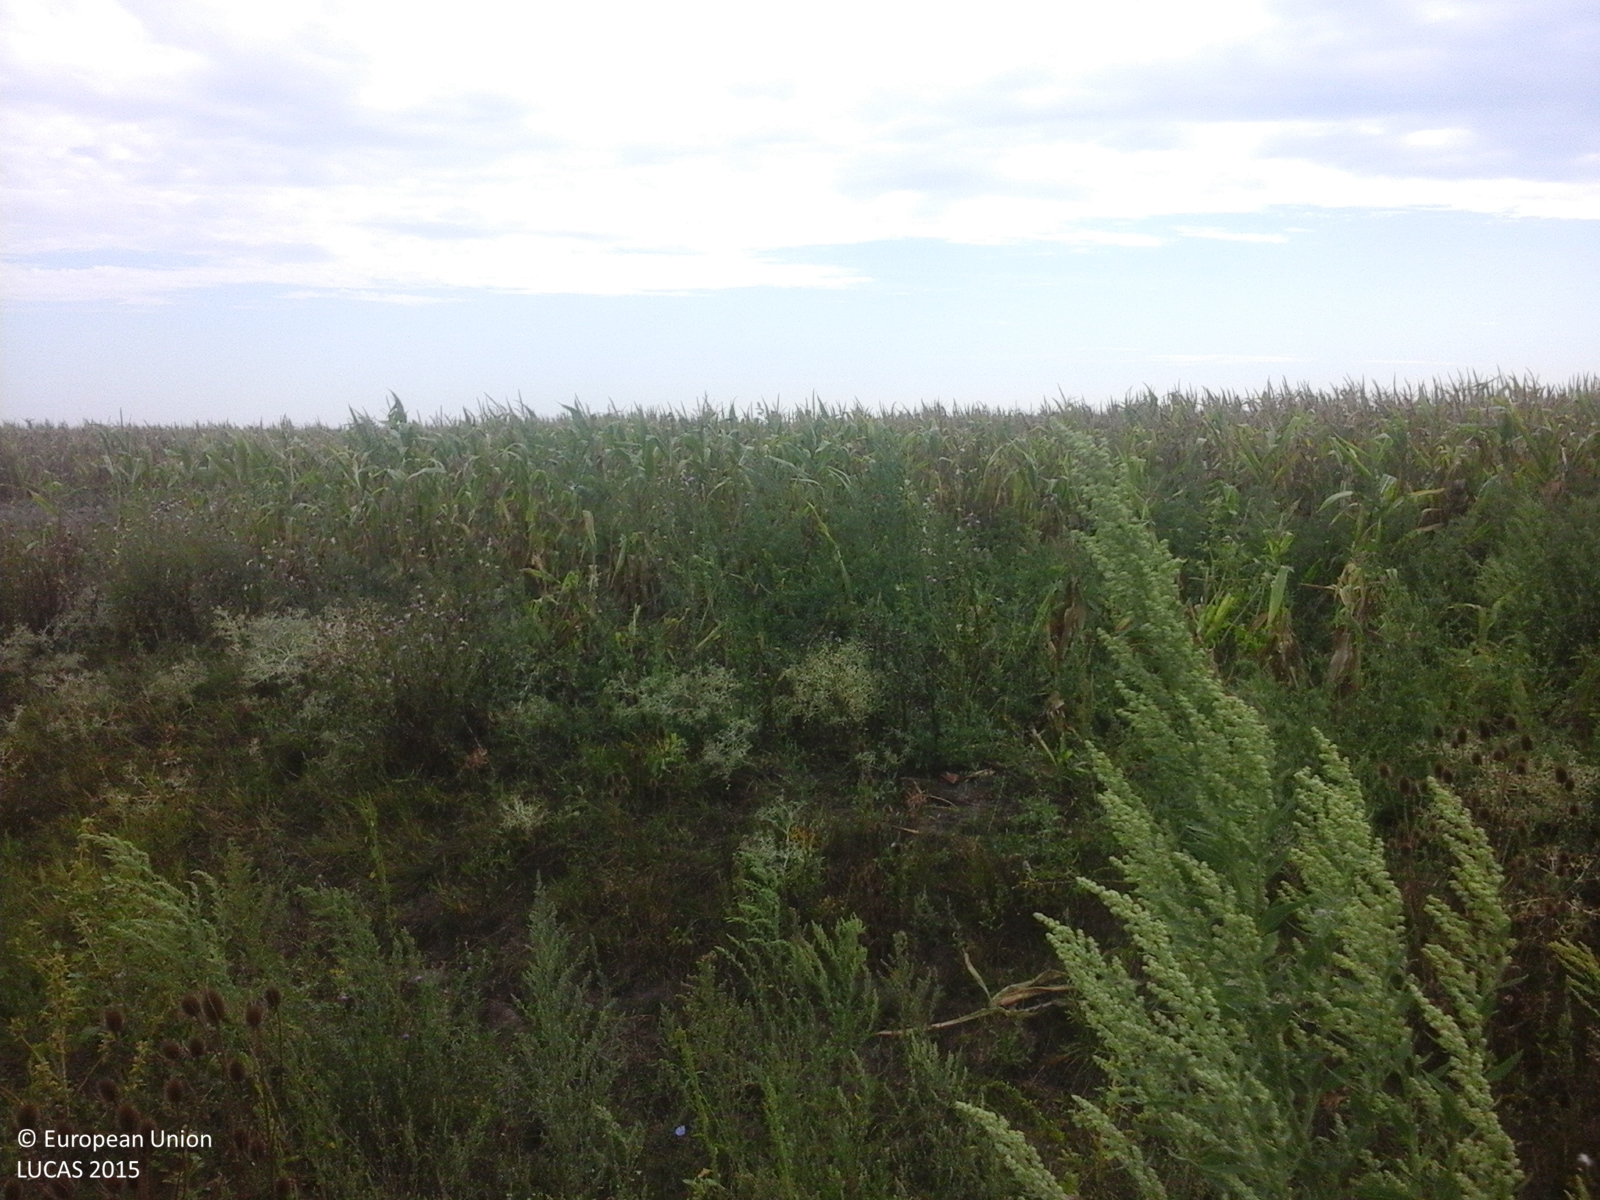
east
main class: Cropland
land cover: Maize
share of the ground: > 75 %
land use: Agriculture (excluding fallow land and kitchen gardens)
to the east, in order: Maize
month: August
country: RO
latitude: 46.3364
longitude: 21.4295
